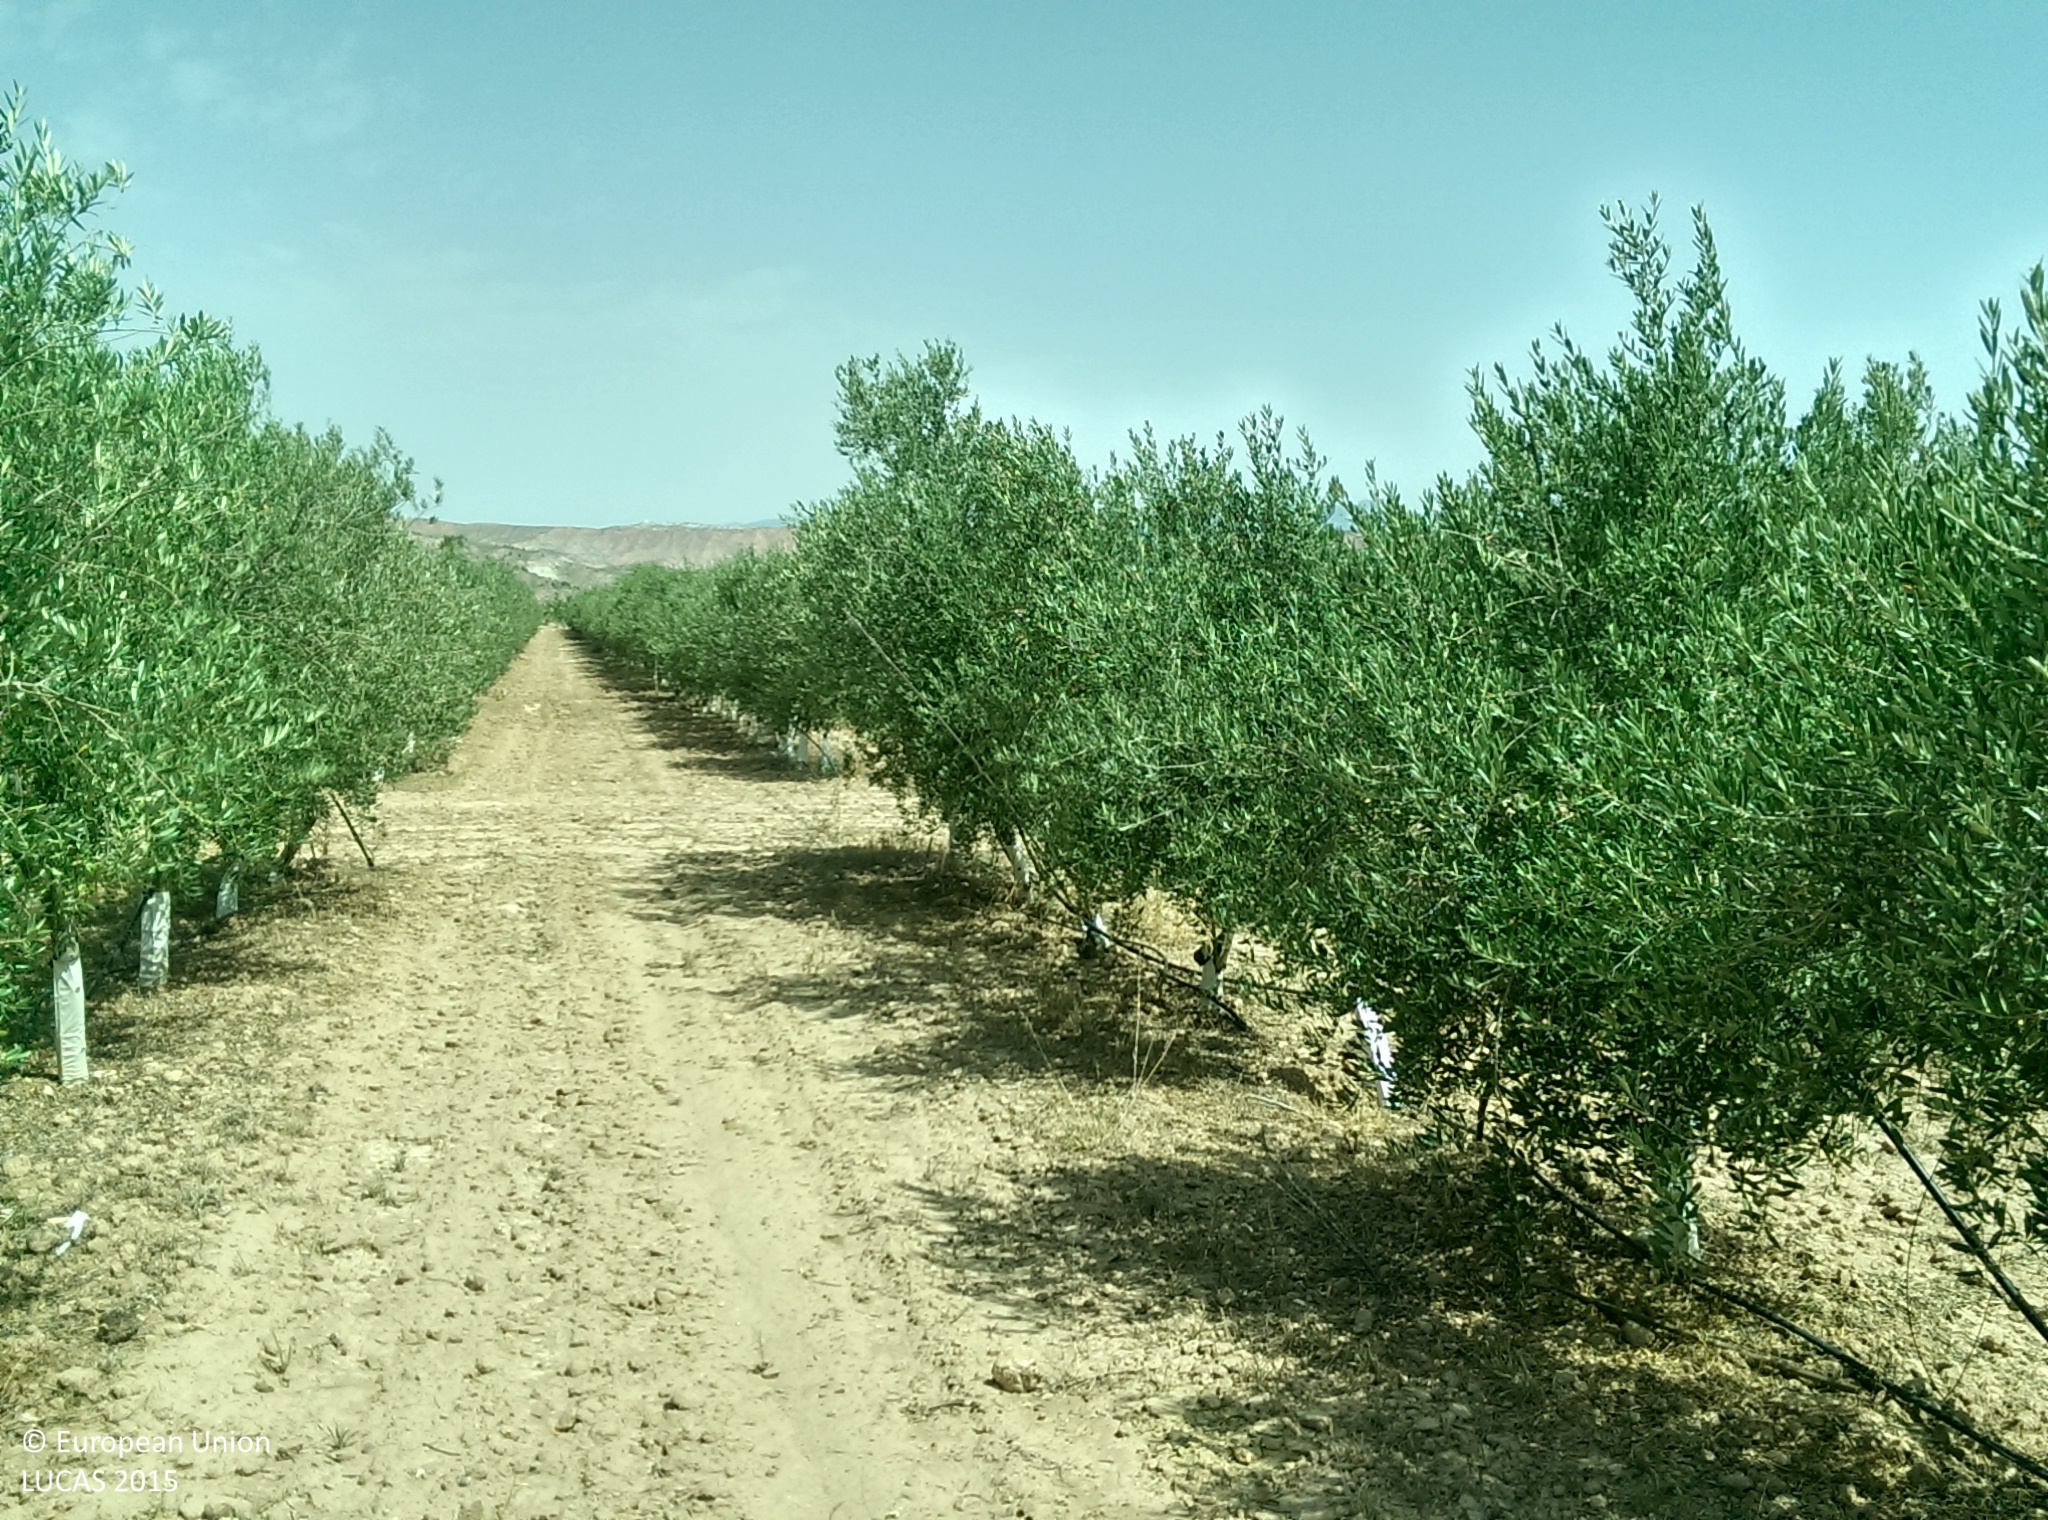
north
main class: Cropland
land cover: Olive groves
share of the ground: 50 - 75 %
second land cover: Other bare soil
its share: > 75 %
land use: Agriculture (excluding fallow land and kitchen gardens)
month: July
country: ES
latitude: 37.5370
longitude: -2.9472
